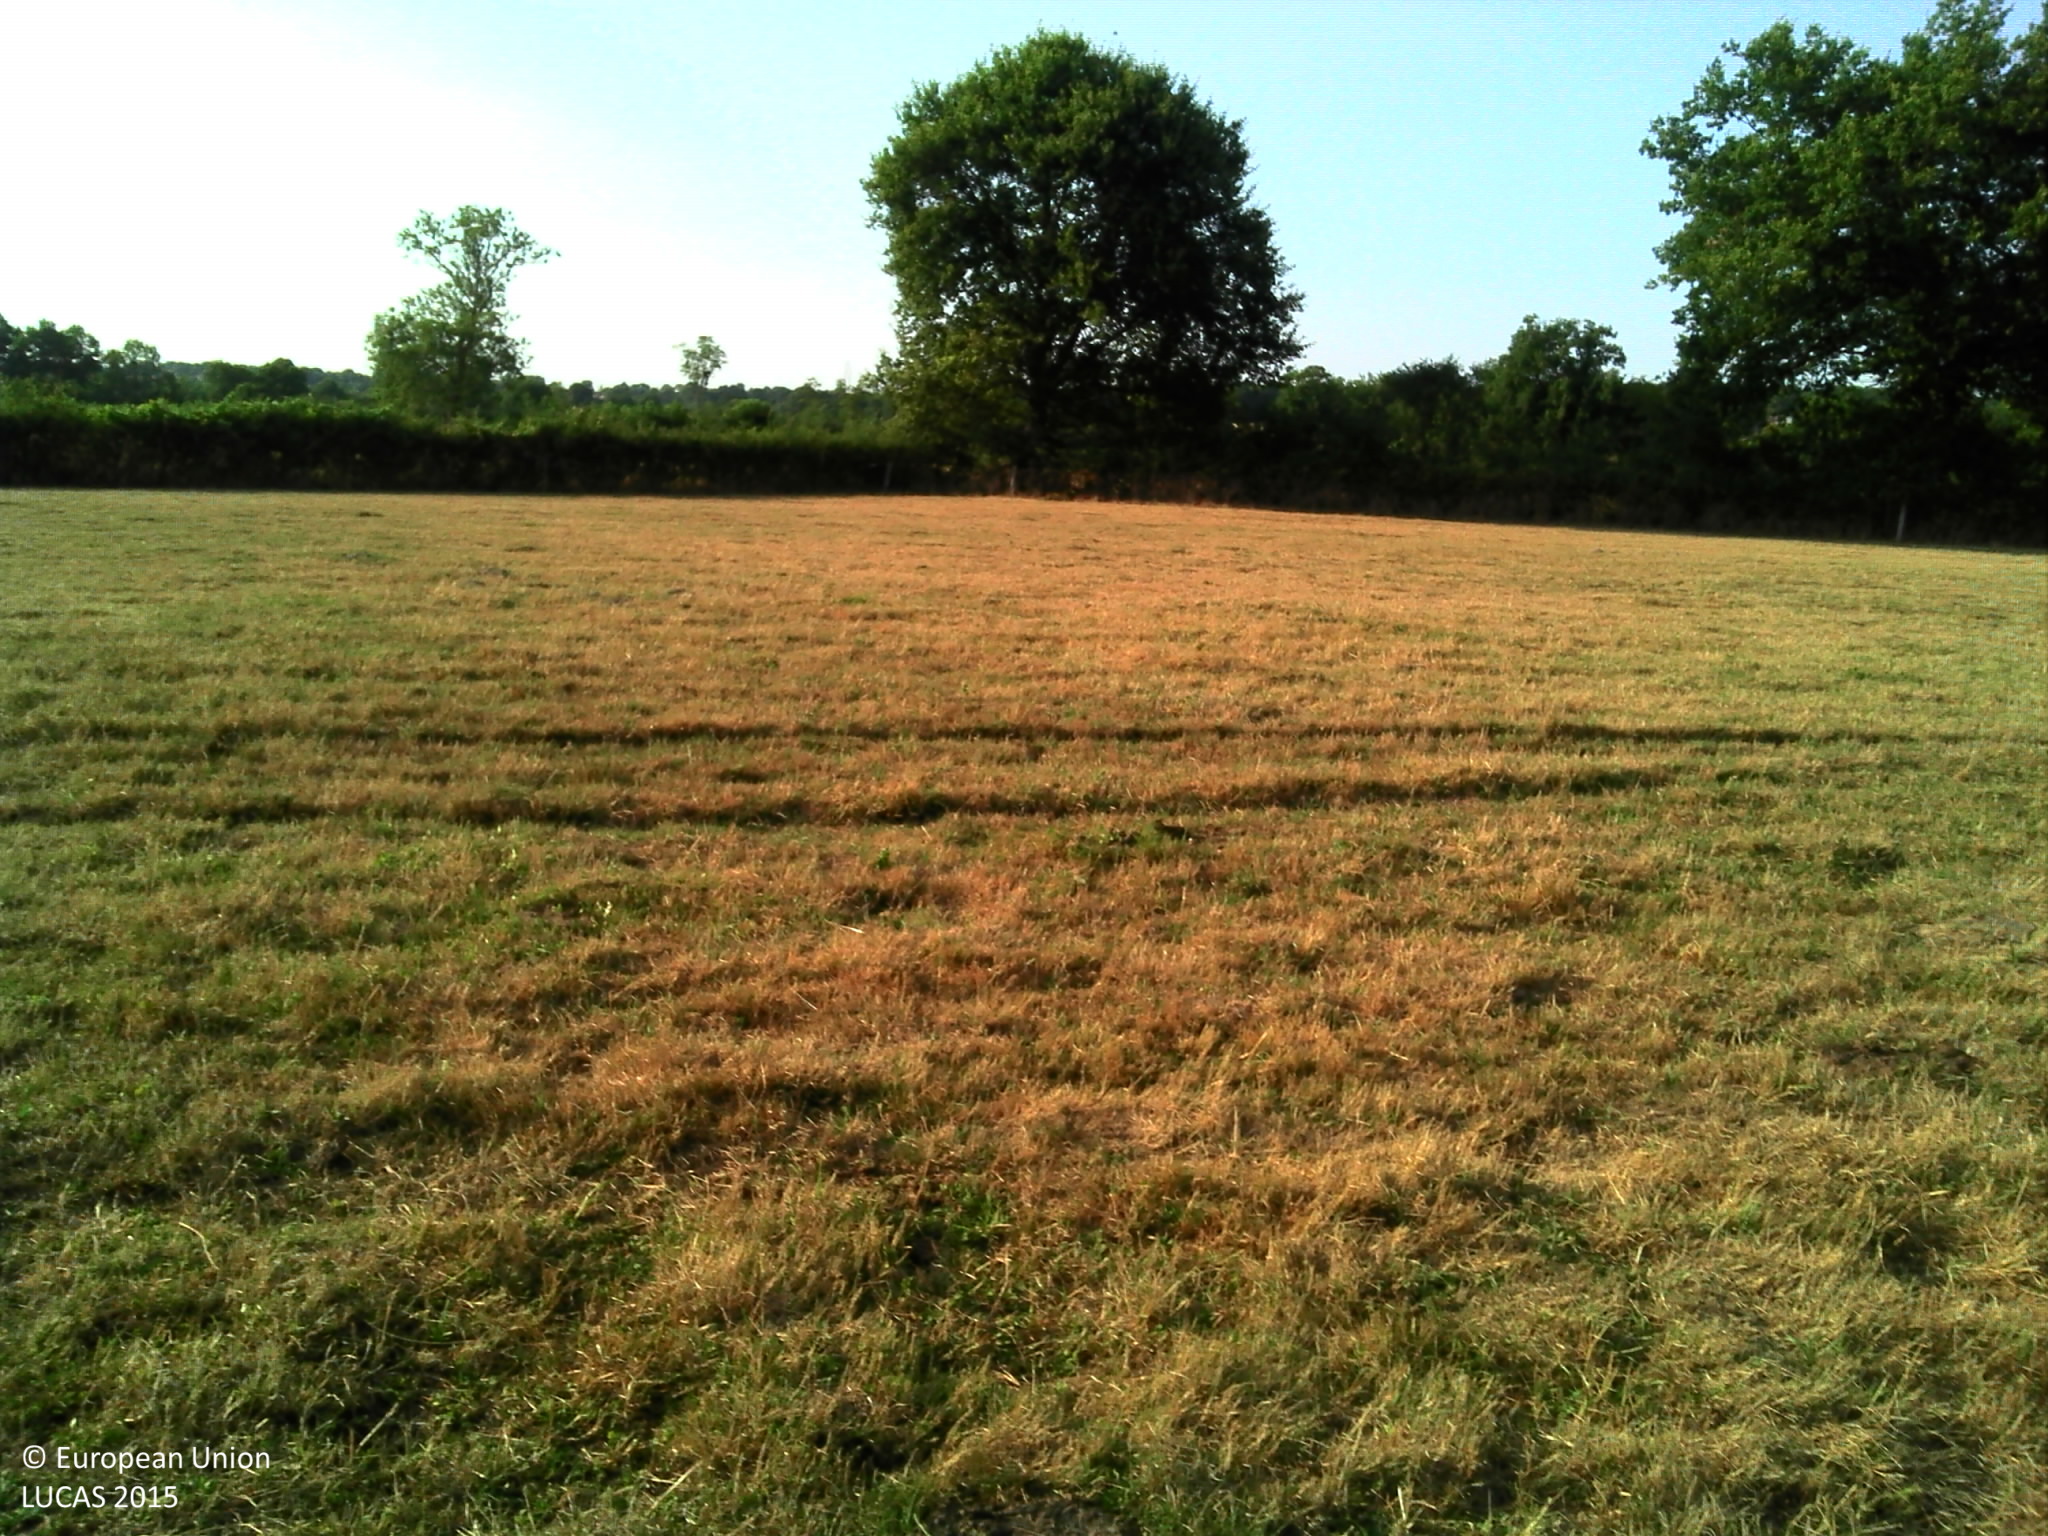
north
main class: Grassland
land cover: Grassland without tree/shrub cover
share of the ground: > 75 %
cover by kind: herbaceous plants 100 %
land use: Agriculture (excluding fallow land and kitchen gardens)
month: July
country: FR
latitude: 46.7749
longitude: 3.6206
